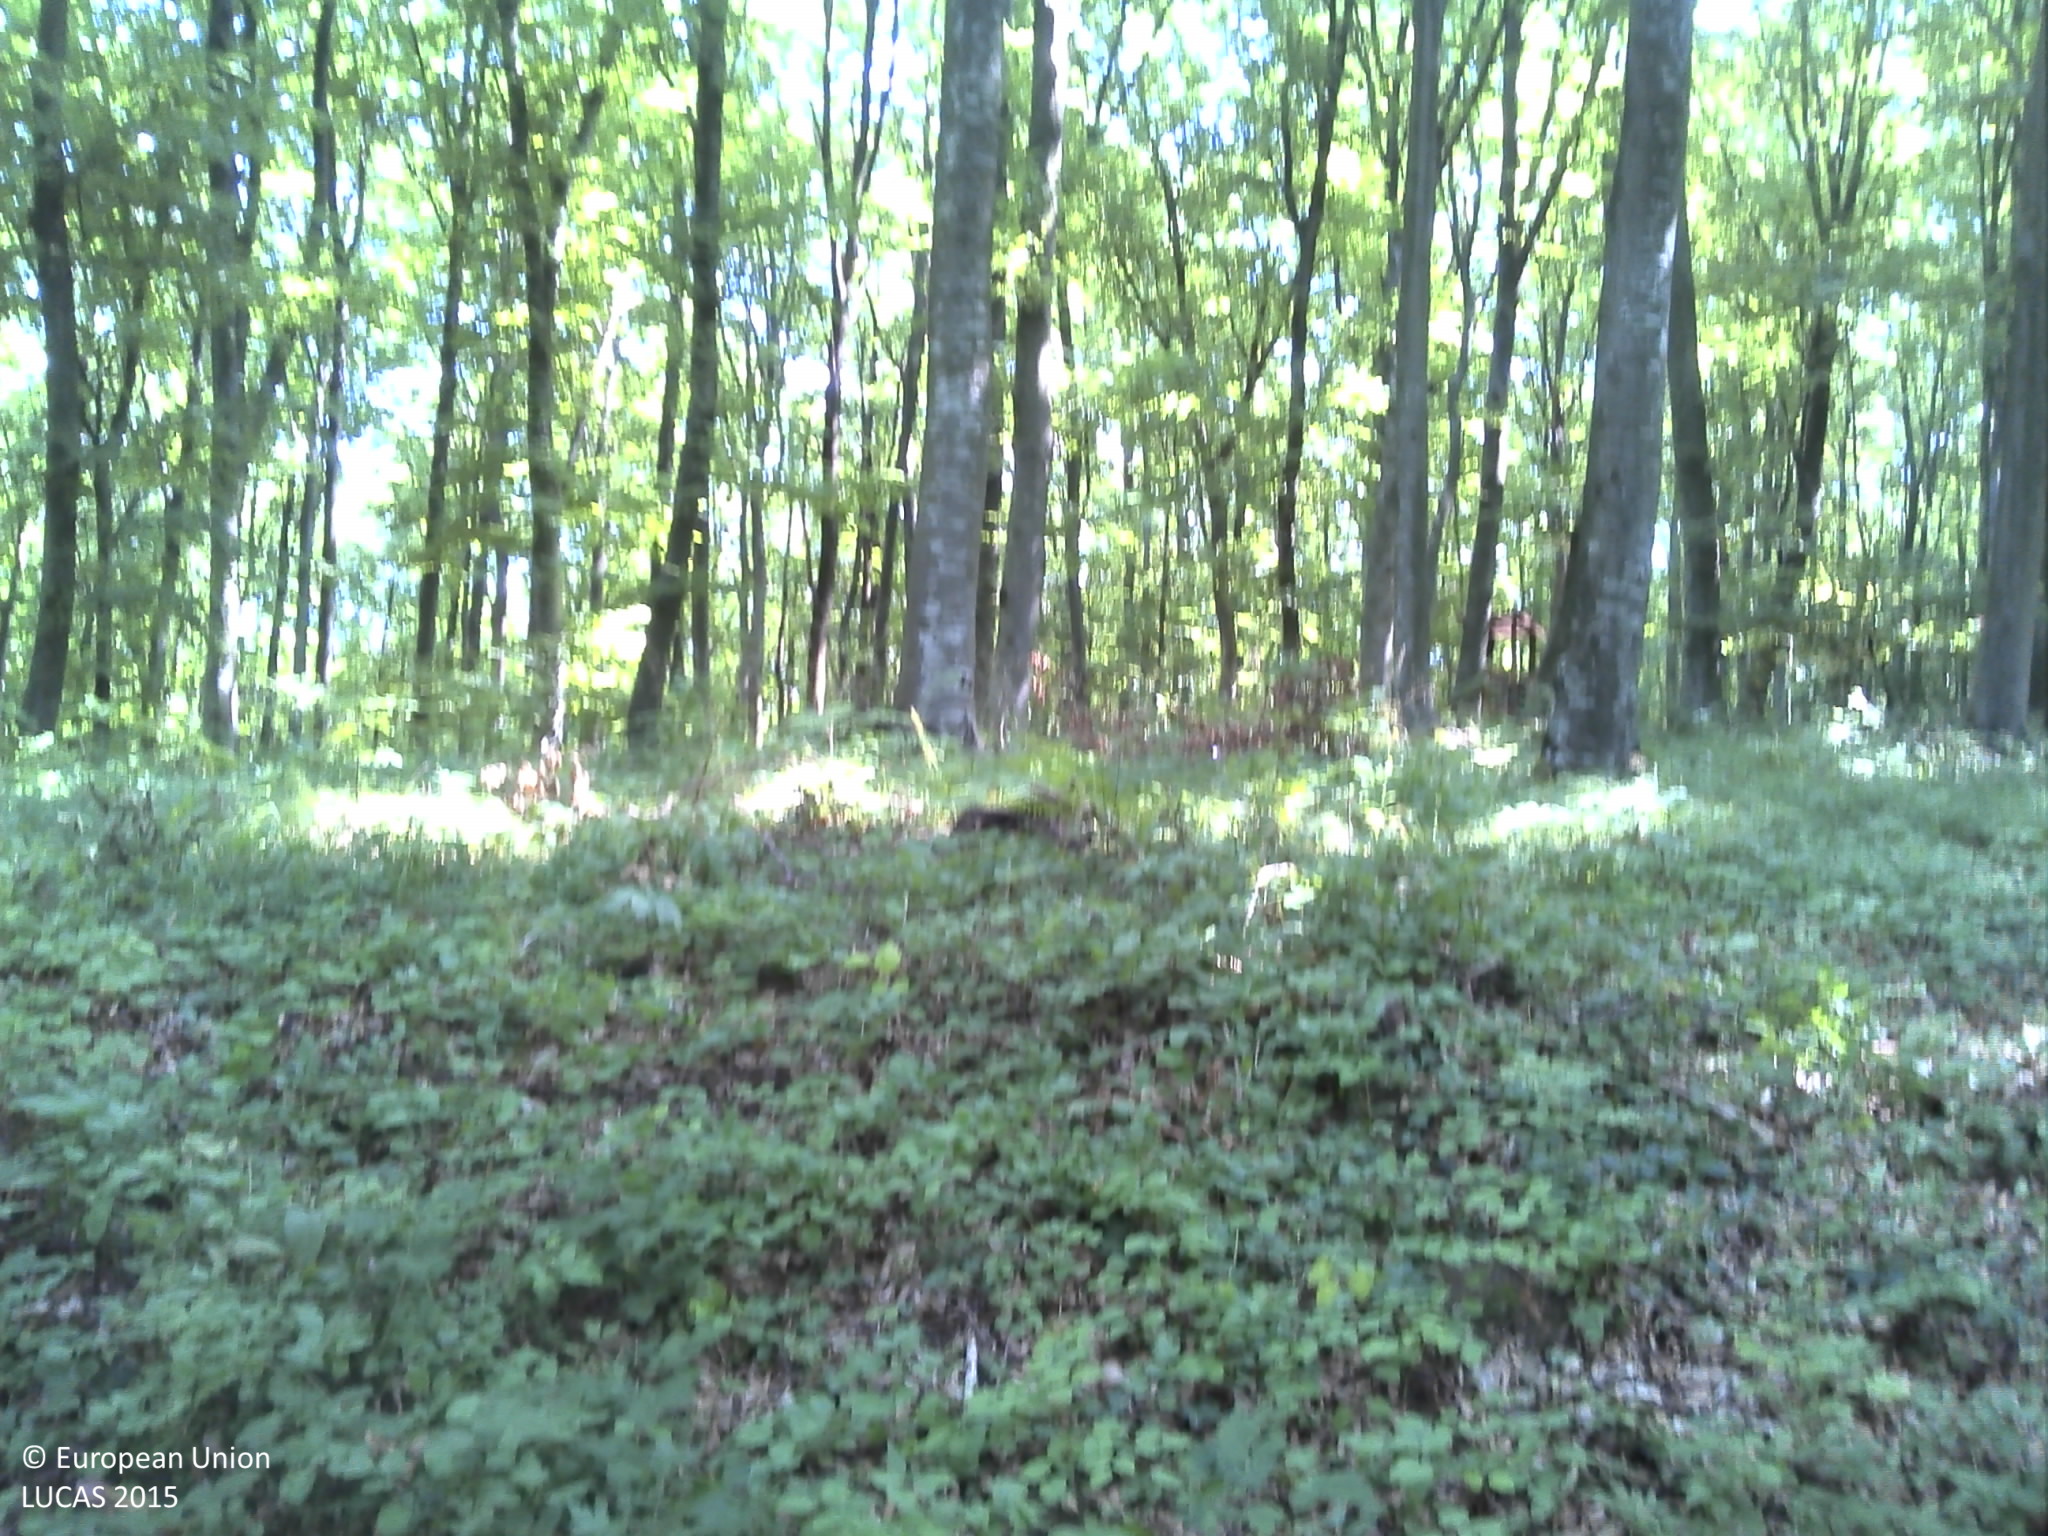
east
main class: Woodland
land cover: Broadleaved woodland
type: acidophilous oak and oak-birch forest
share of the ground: > 75 %
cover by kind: broadleaved forest trees 100 %
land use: Forestry
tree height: > 5 m
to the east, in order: Broadleaved woodland; Tracks; Broadleaved woodland
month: August
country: HR
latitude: 45.2712
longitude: 17.5337
